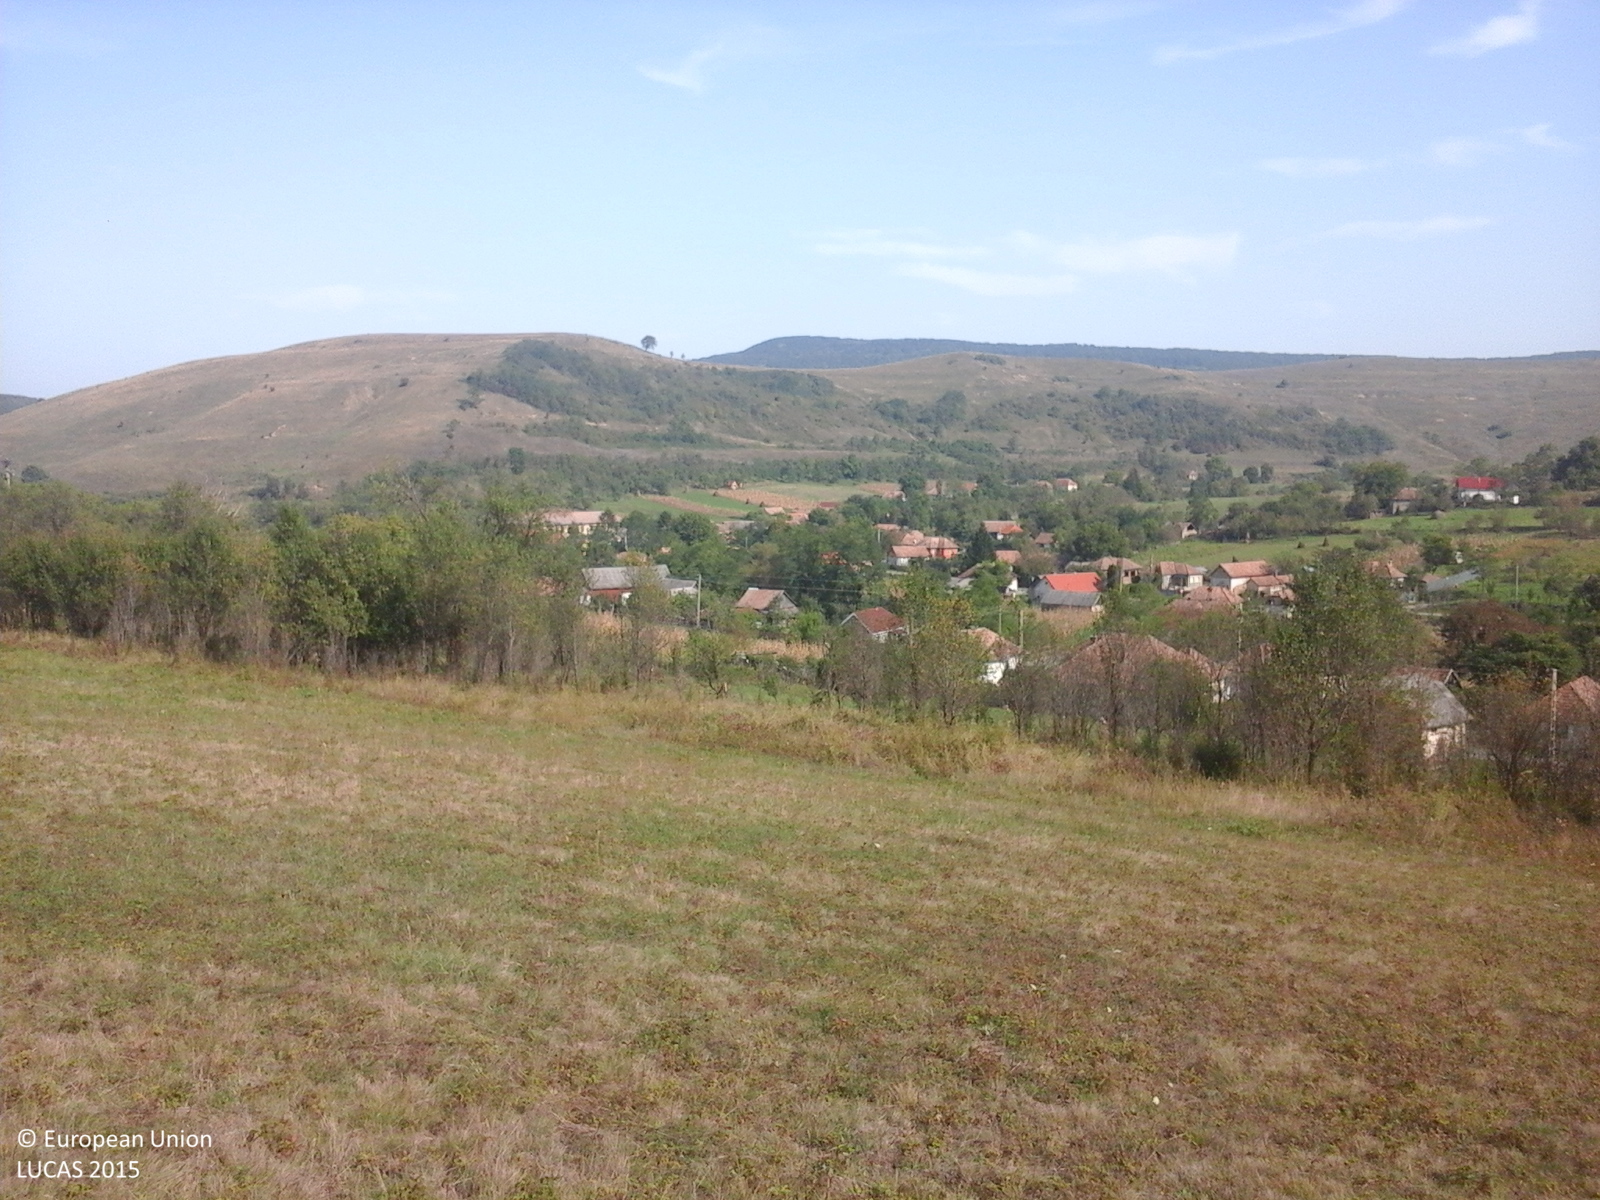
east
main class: Grassland
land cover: Grassland without tree/shrub cover
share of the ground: > 75 %
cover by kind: herbaceous plants 100 %
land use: Agriculture (excluding fallow land and kitchen gardens)
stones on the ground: < 10 %
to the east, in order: Grassland without tree/shrub cover; Spontaneously vegetated surfaces; Other fruit trees and berries; Grassland without tree/shrub cover; Fences; Maize; Grassland with sparse tree/shrub cover; Maize; Electric lines; Maize; Potatoes; Maize; Artificial constructions in urban areas
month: September
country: RO
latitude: 47.1269
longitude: 23.6924
